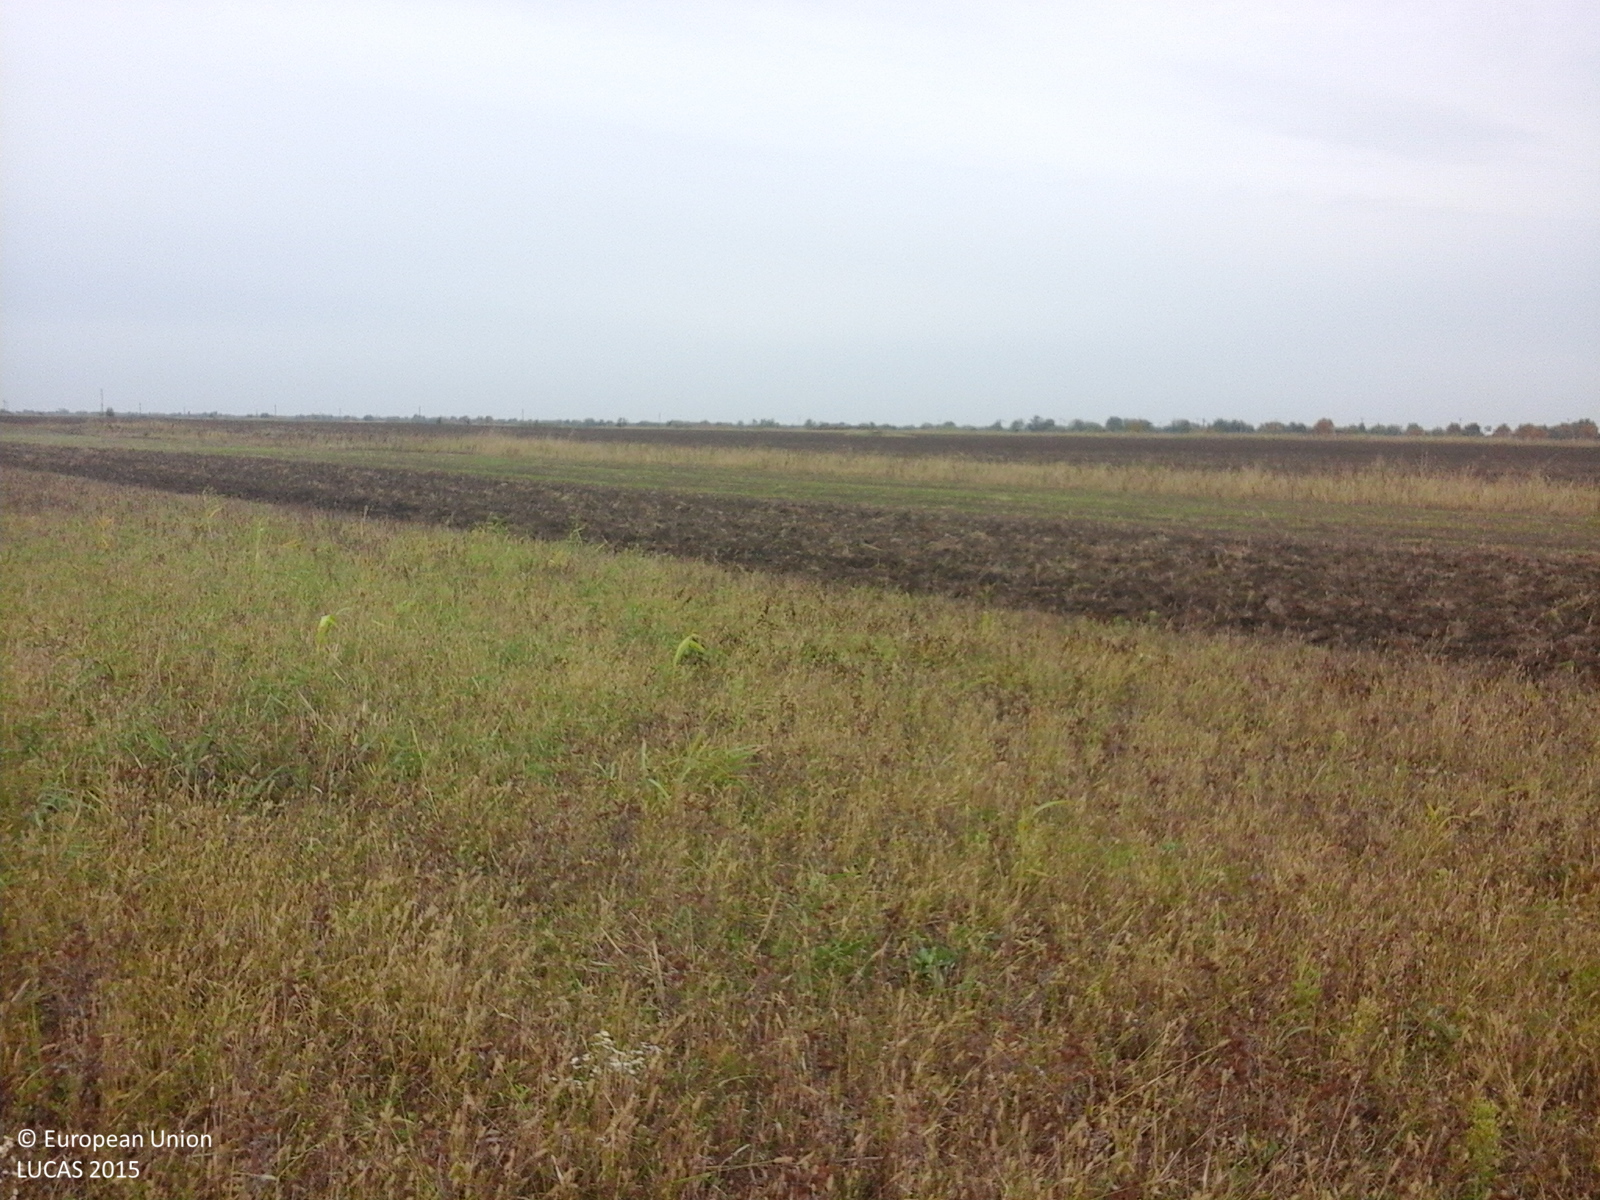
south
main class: Grassland
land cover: Spontaneously vegetated surfaces
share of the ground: > 75 %
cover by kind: herbaceous plants 100 %
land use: Fallow land
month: October
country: RO
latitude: 44.8536
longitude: 26.4021
